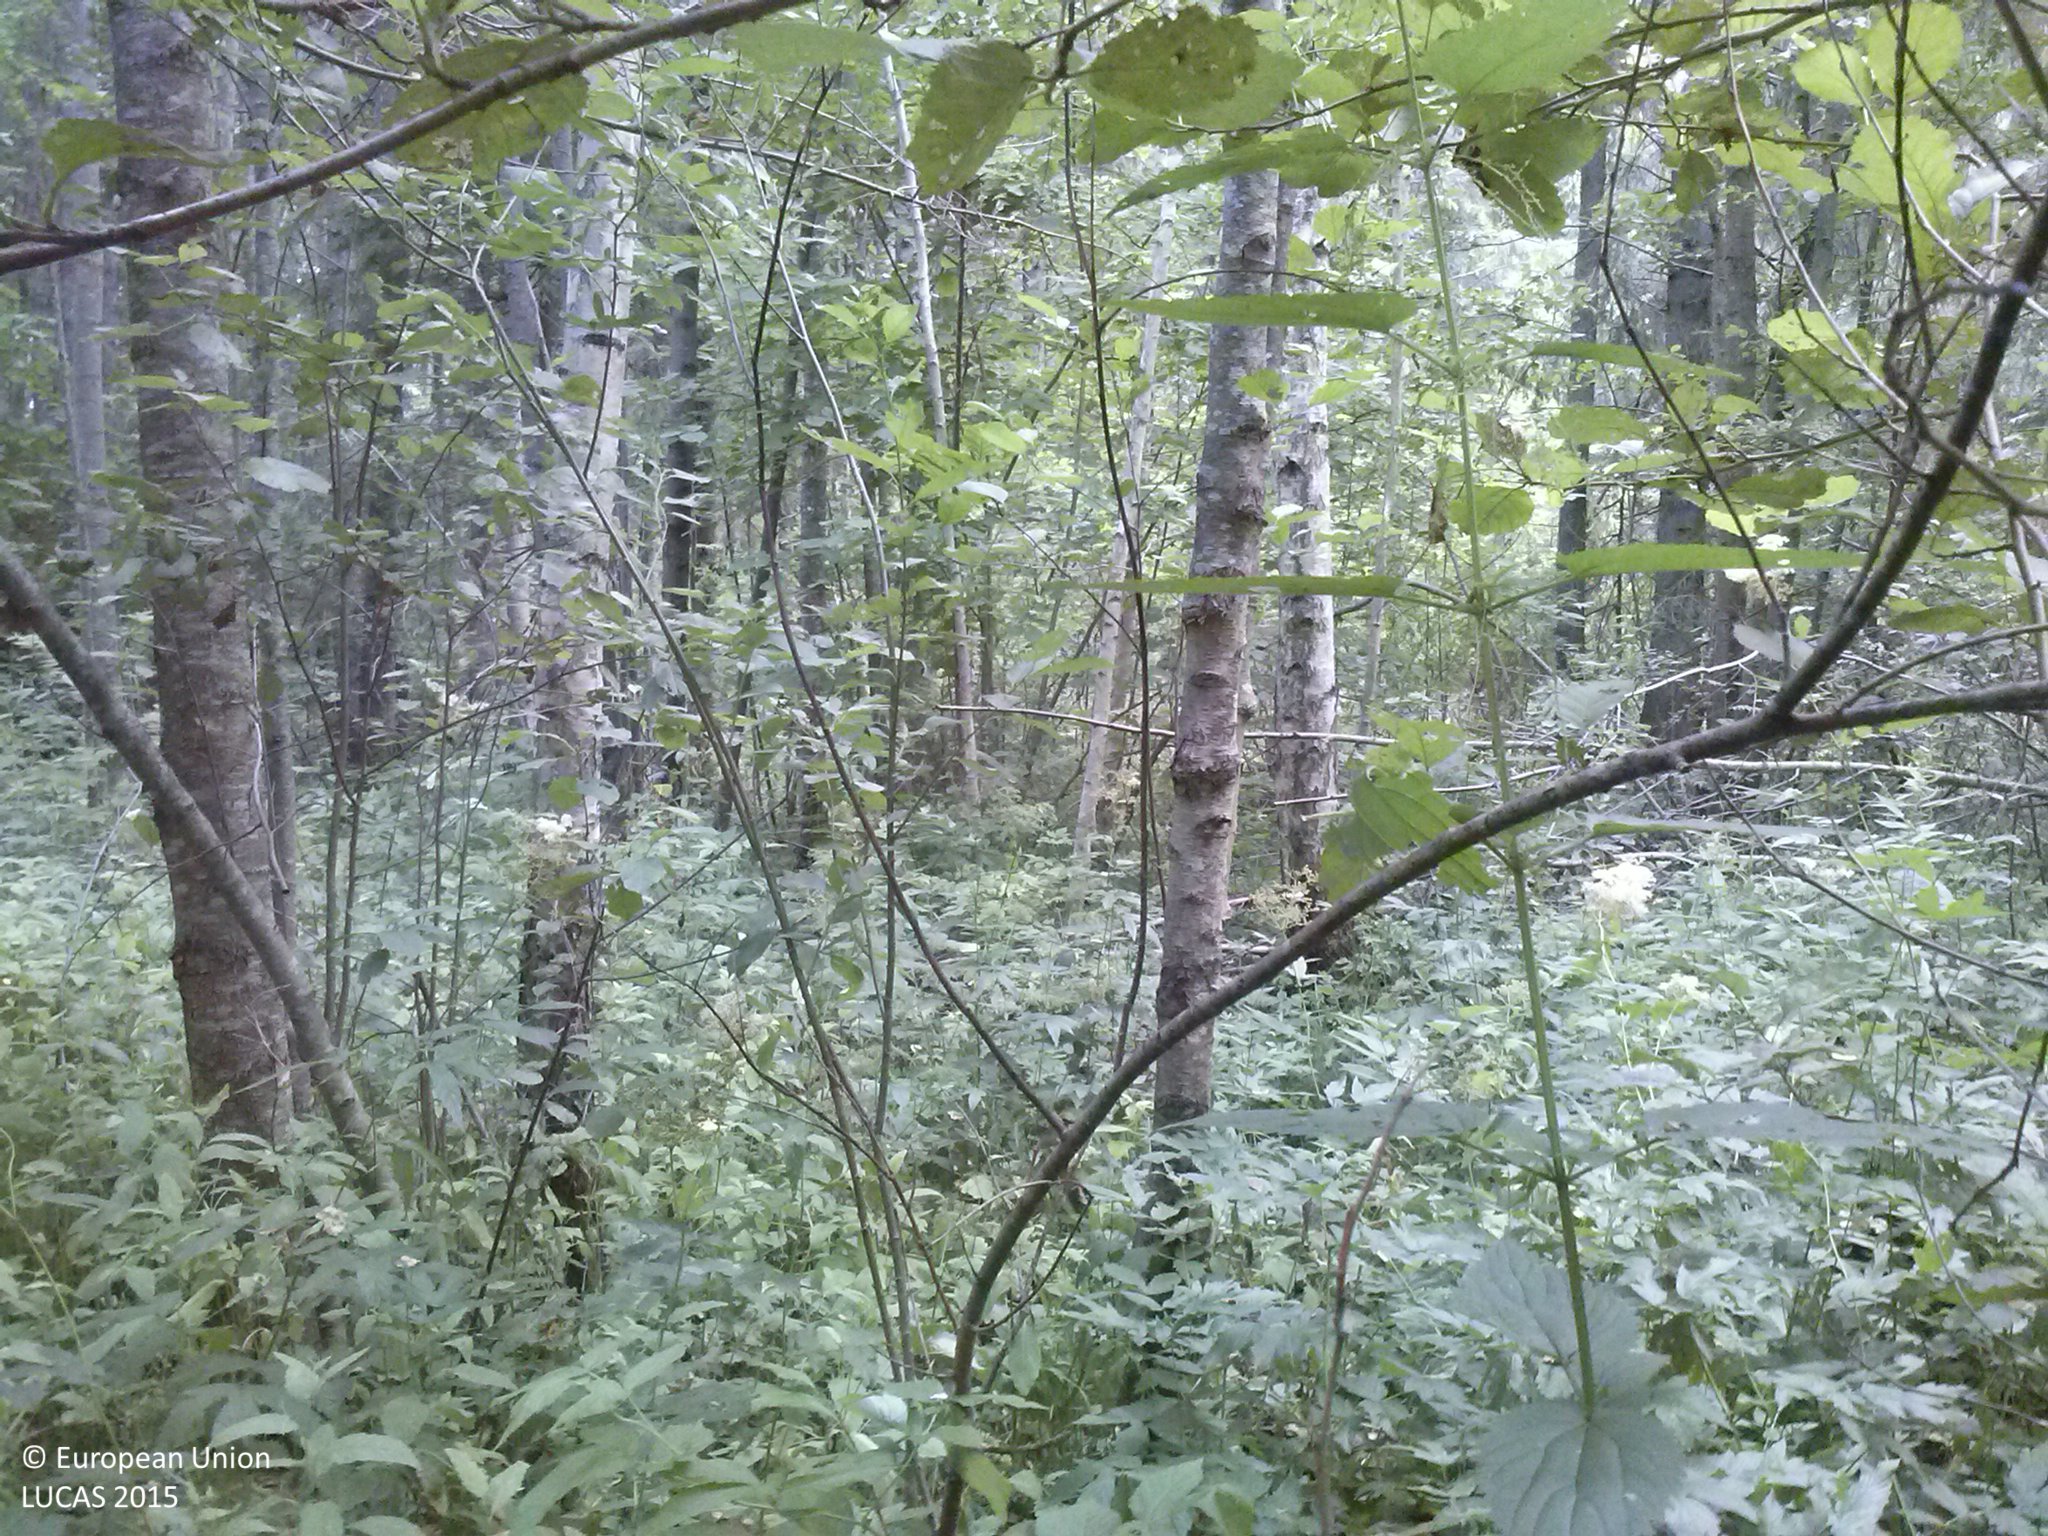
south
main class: Woodland
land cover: Broadleaved woodland
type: non-riverine alder, birch or aspen forest
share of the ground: > 75 %
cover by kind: broadleaved forest trees 75 %, herbaceous plants 15 %, shrubs 10 %
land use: Forestry
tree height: > 5 m
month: July
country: LV
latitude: 56.5562
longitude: 26.9681
